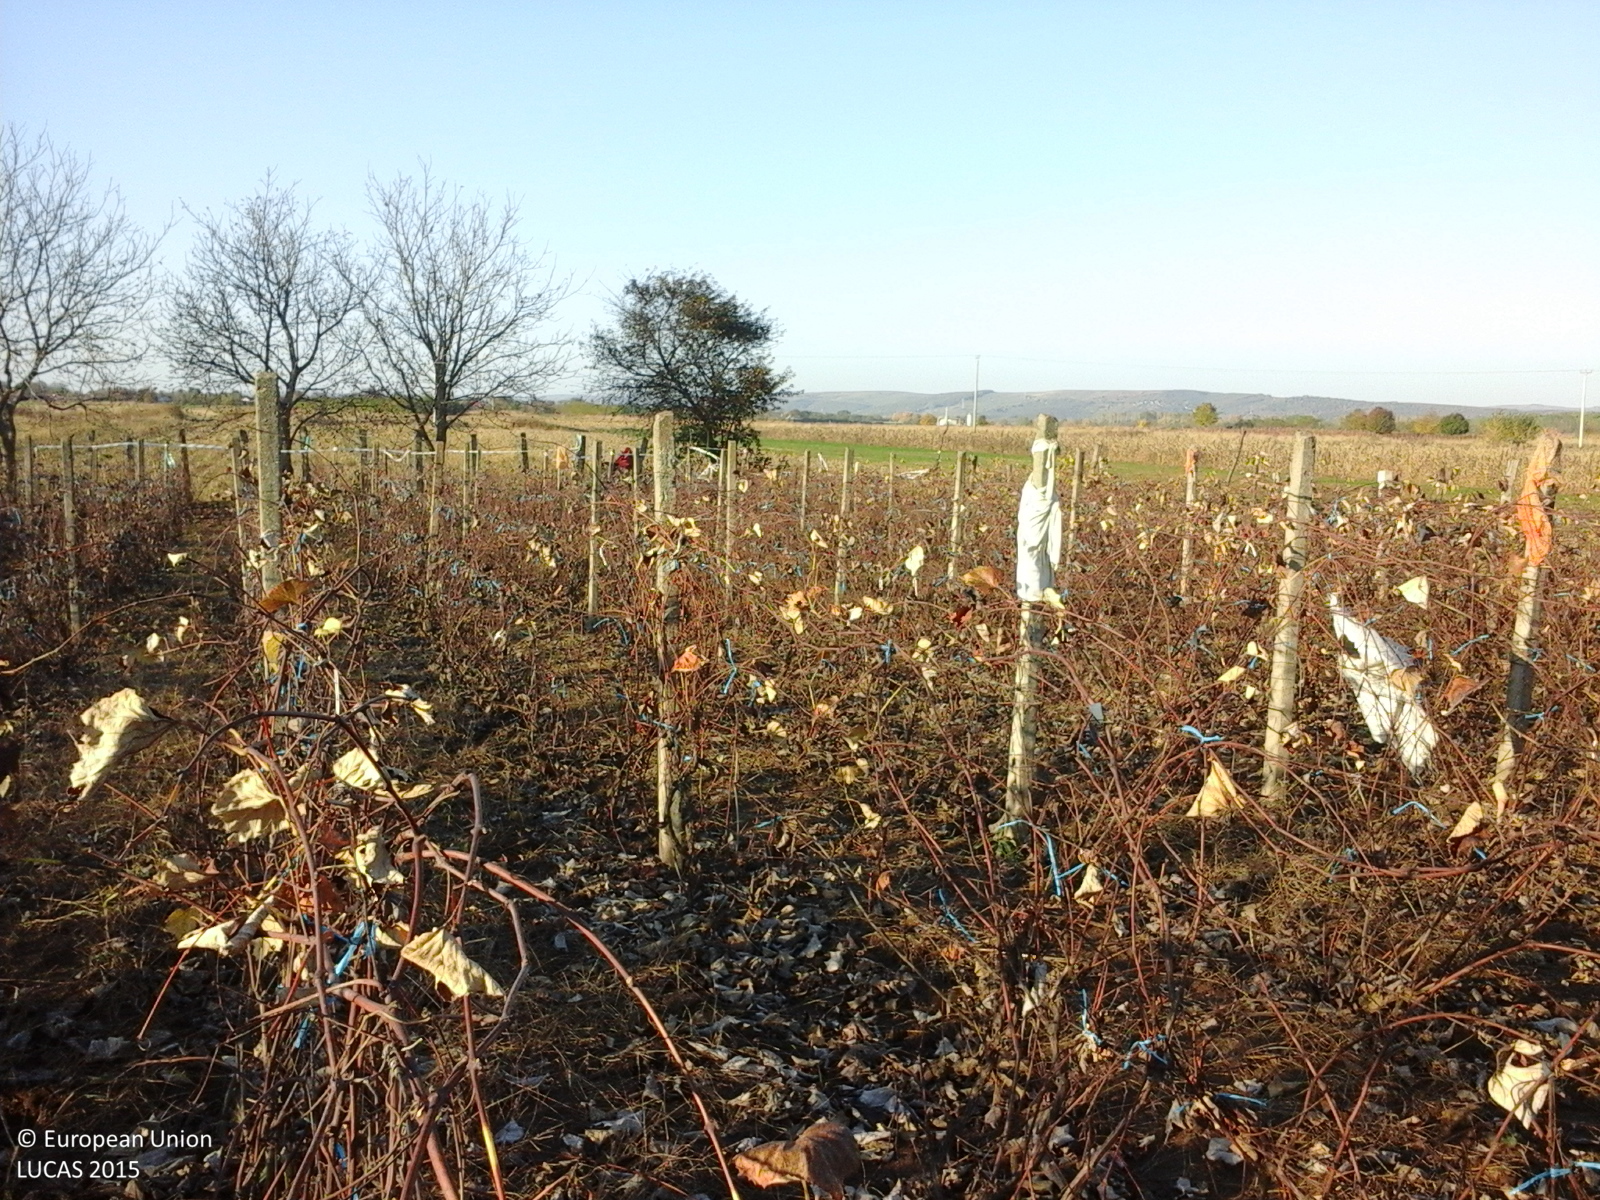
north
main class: Cropland
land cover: Vineyards
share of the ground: 50 - 75 %
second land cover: Other bare soil
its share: > 75 %
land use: Agriculture (excluding fallow land and kitchen gardens)
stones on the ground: < 10 %
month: October
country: RO
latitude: 46.1230
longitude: 27.1938
